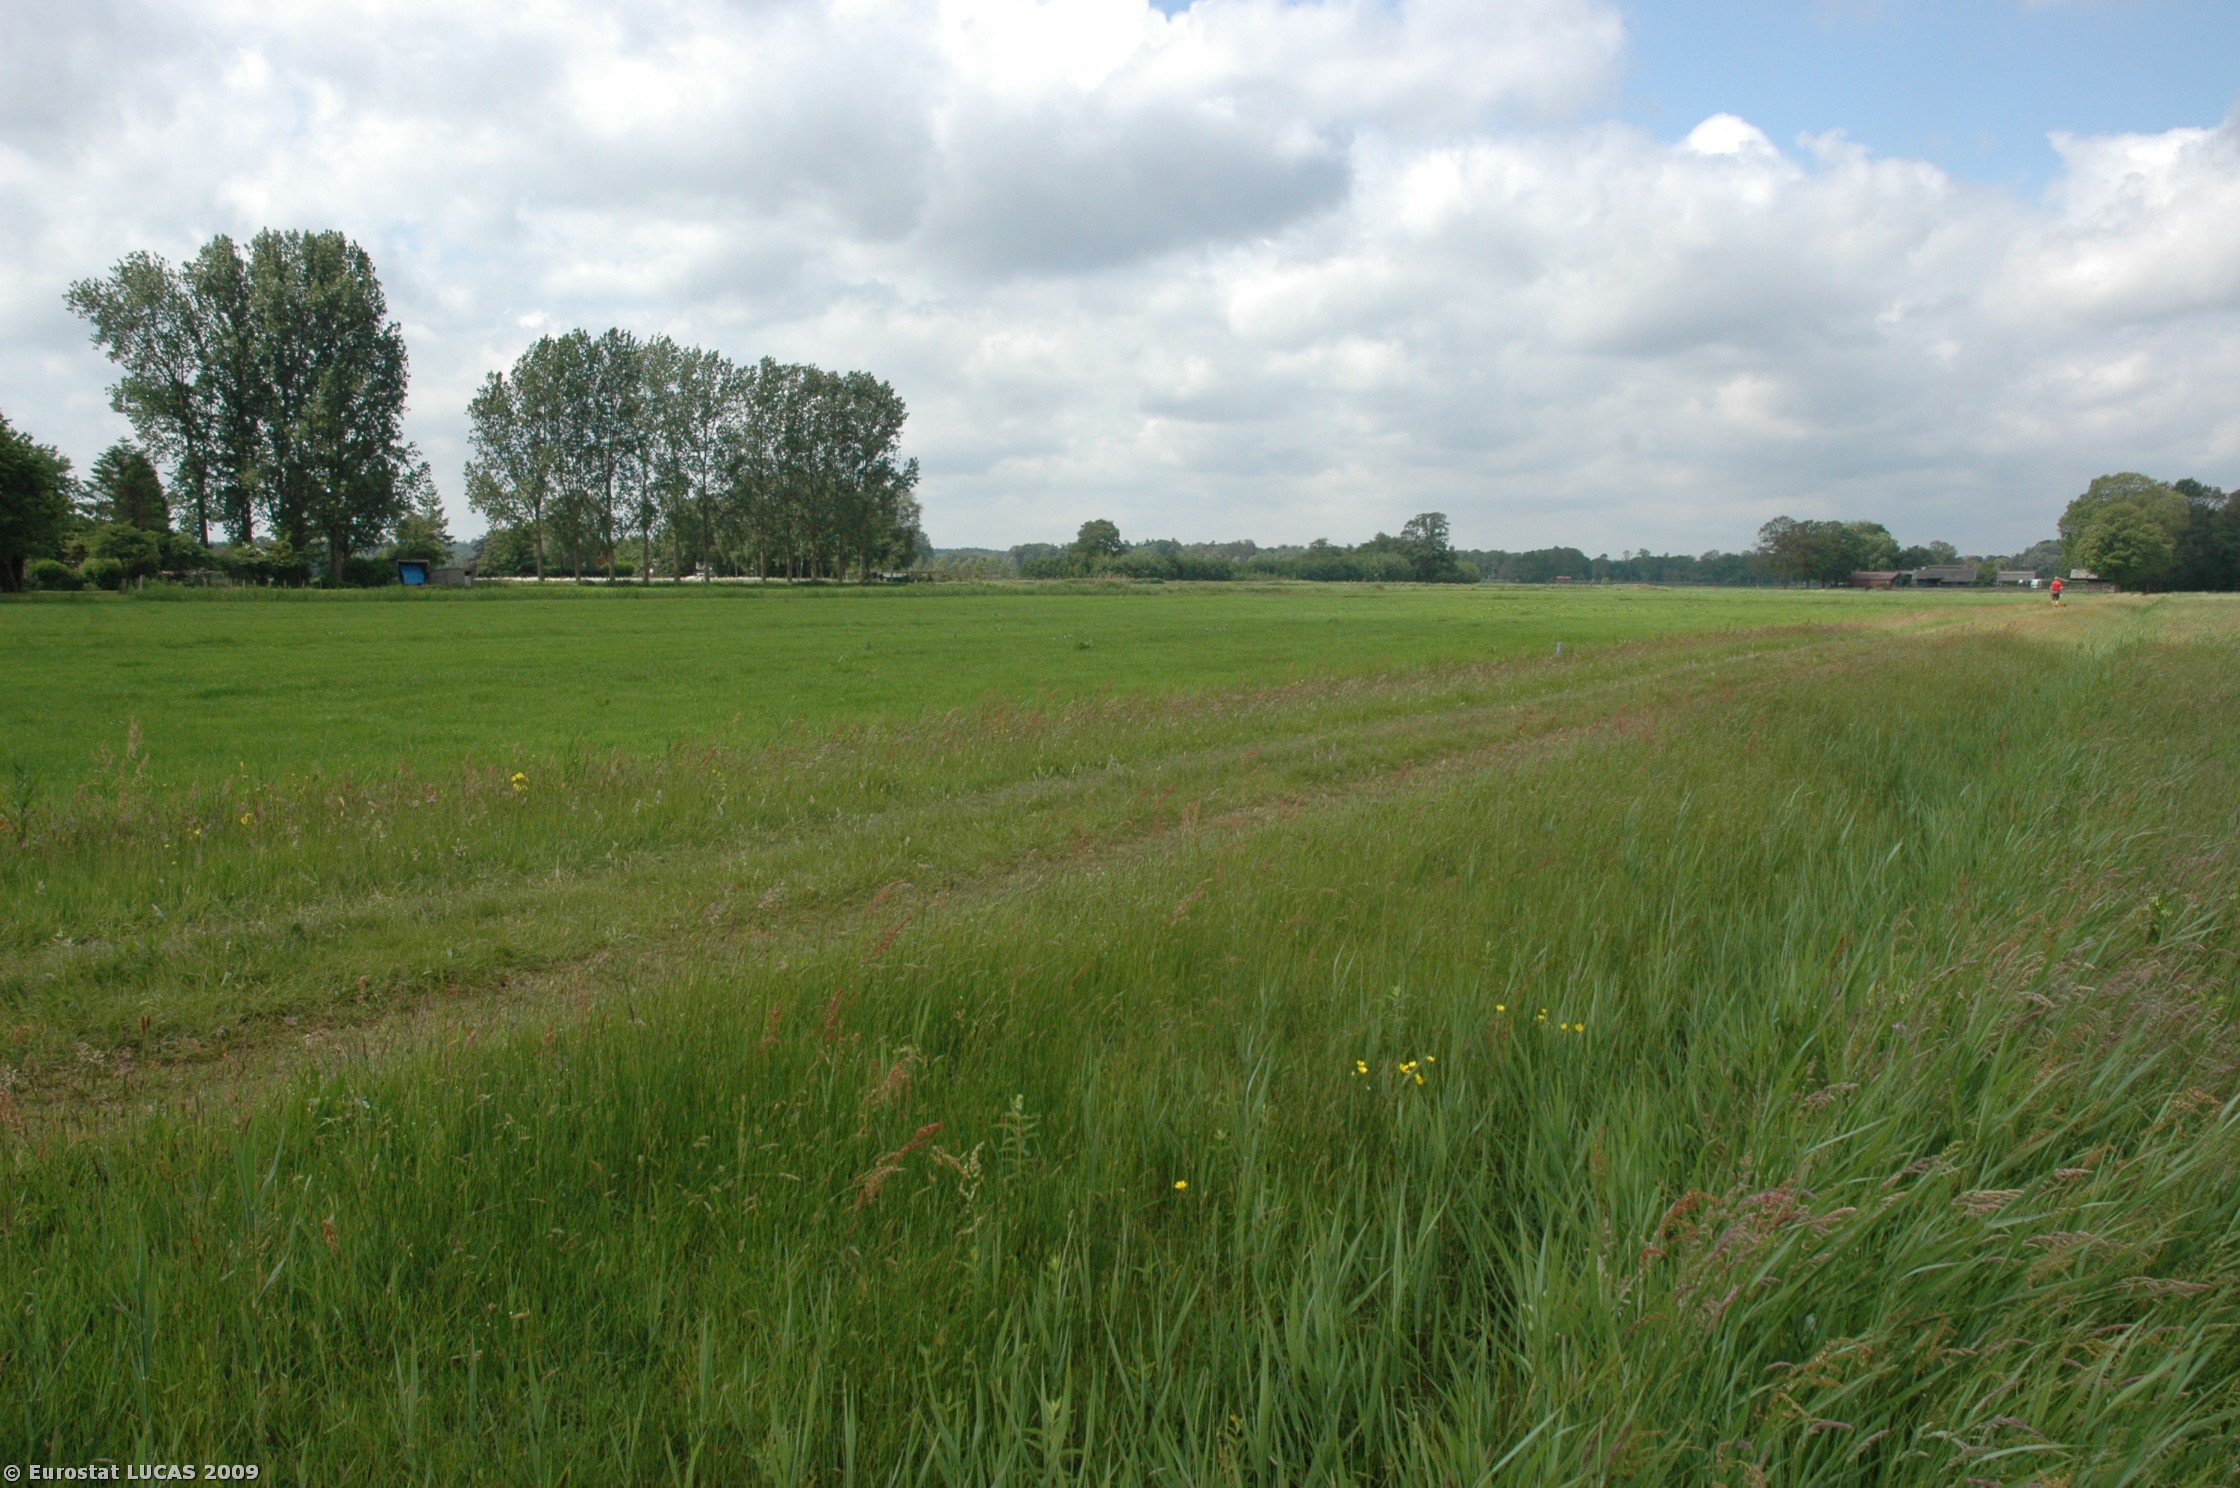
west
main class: Grassland
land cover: Grassland without tree/shrub cover
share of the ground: > 75 %
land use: Agriculture (excluding fallow land and kitchen gardens)
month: May
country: NL
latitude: 52.0796
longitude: 6.1032
